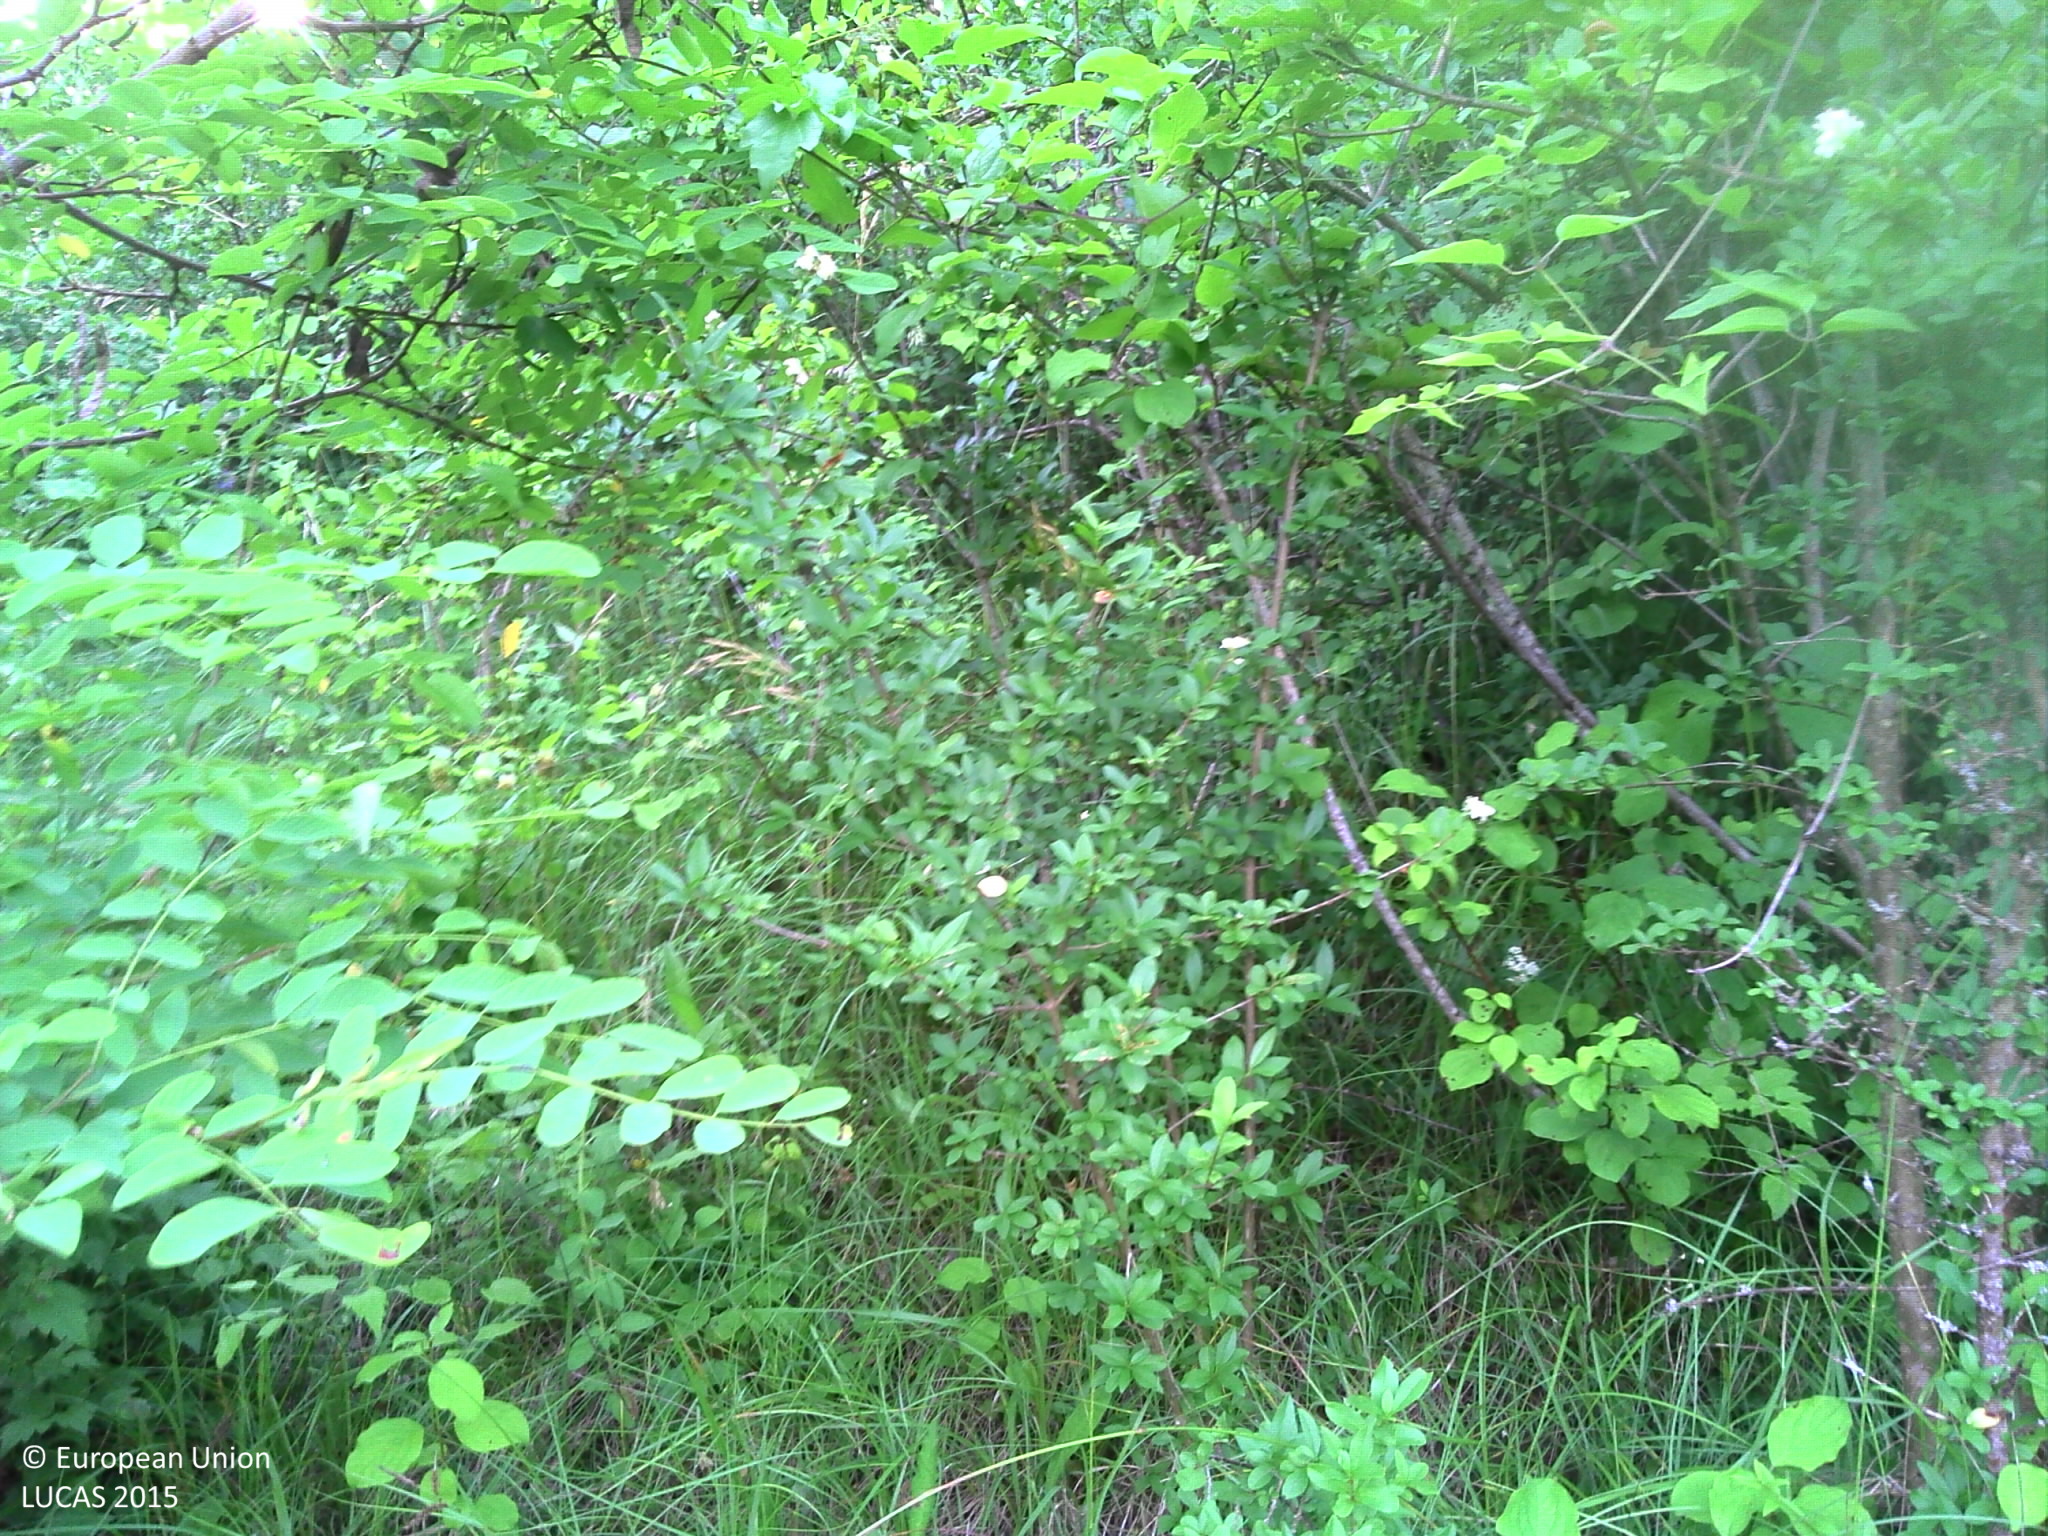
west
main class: Shrubland
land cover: Shrubland with sparse tree cover
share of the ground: > 75 %
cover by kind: shrubs 80 %, herbaceous plants 15 %, broadleaved forest trees 5 %
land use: Forestry
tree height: > 5 m
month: June
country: FR
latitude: 45.5784
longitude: 6.1471
